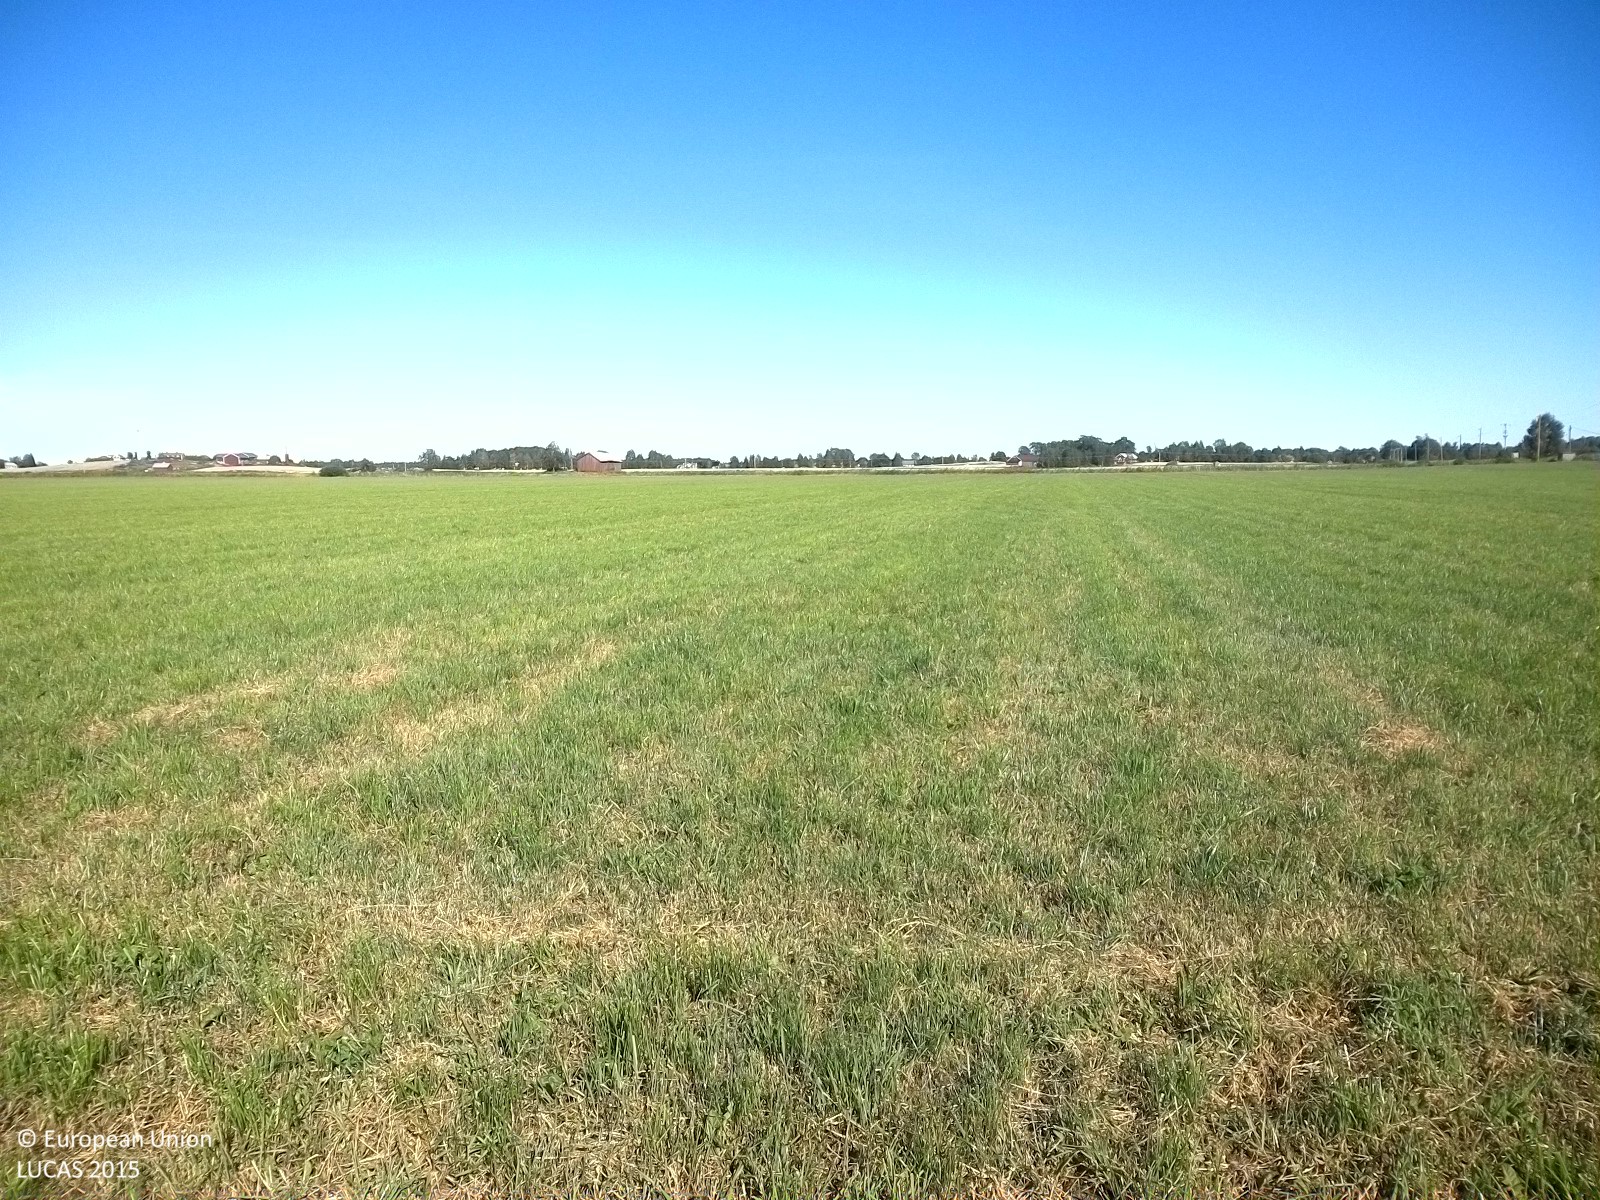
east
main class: Cropland
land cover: Temporary grasslands
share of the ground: > 75 %
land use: Agriculture (excluding fallow land and kitchen gardens)
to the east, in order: Temporary grasslands
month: August
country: SE
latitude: 59.1711
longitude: 15.5029
